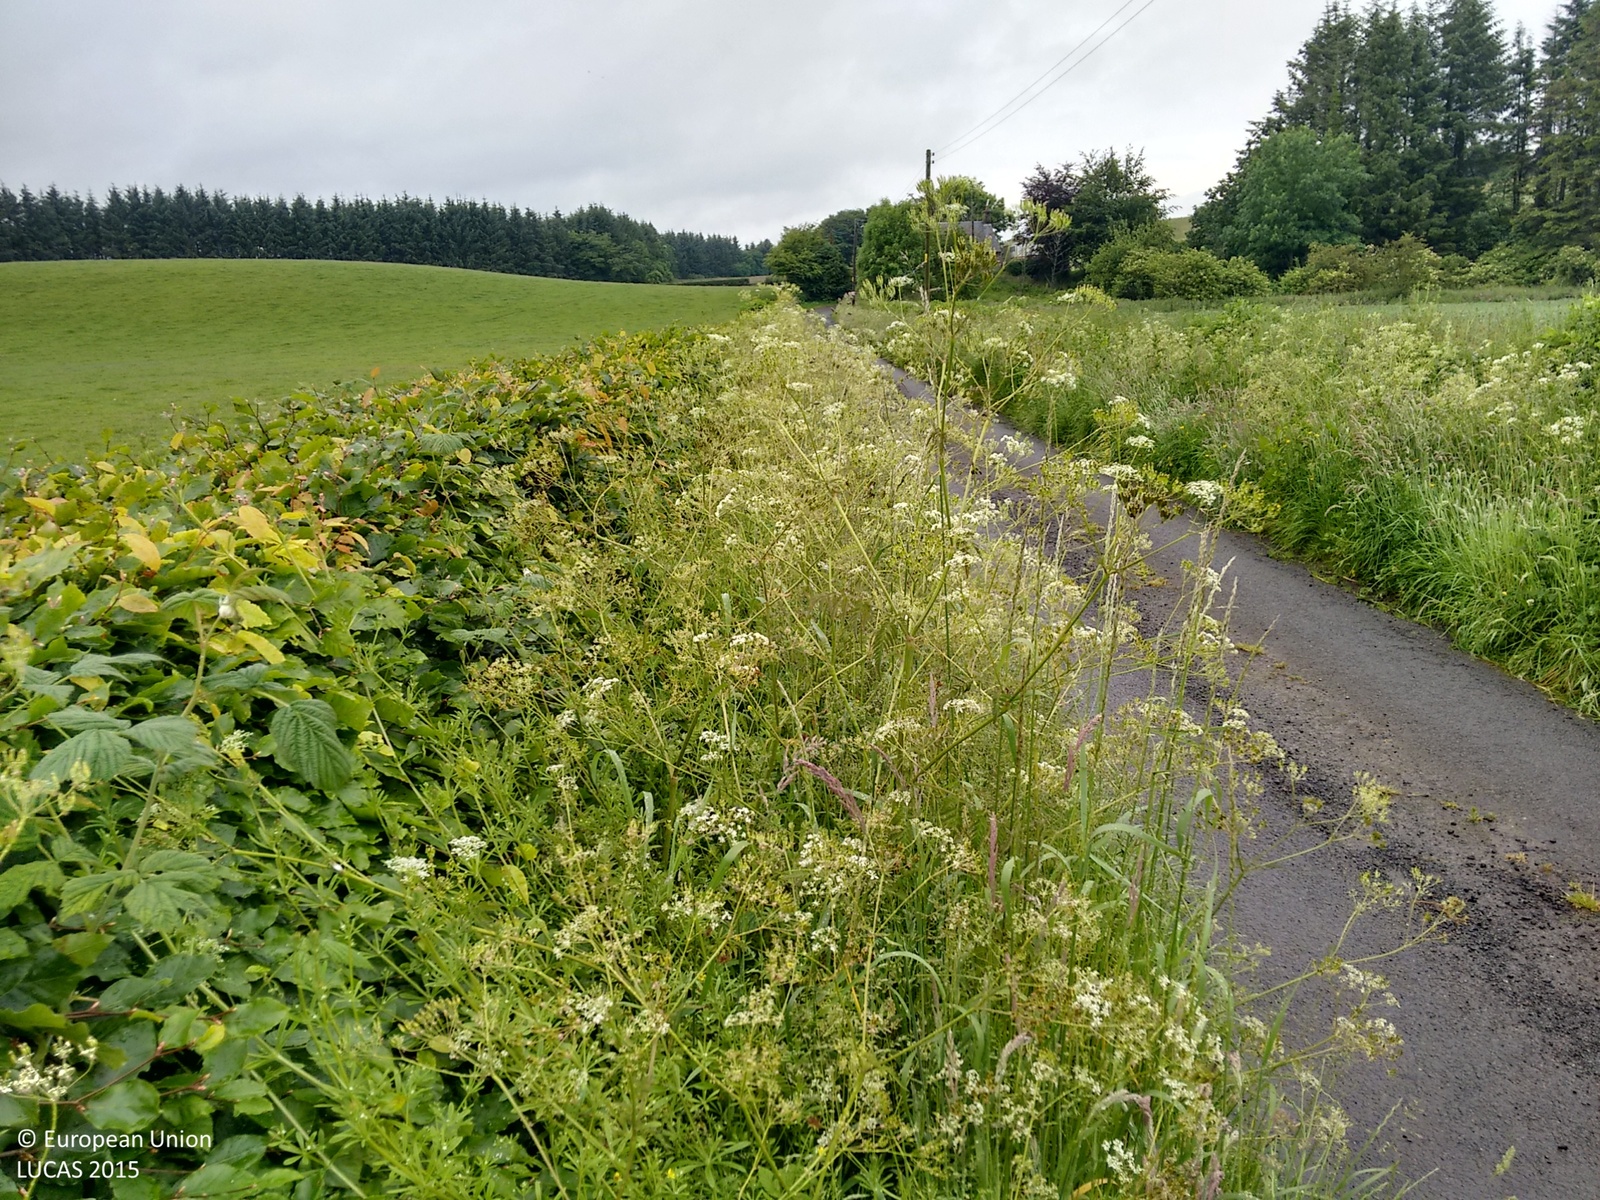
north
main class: Grassland
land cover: Grassland without tree/shrub cover
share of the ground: > 75 %
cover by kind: herbaceous plants 100 %
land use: Agriculture (excluding fallow land and kitchen gardens)
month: June
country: GB
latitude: 55.0496
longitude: -3.3348
